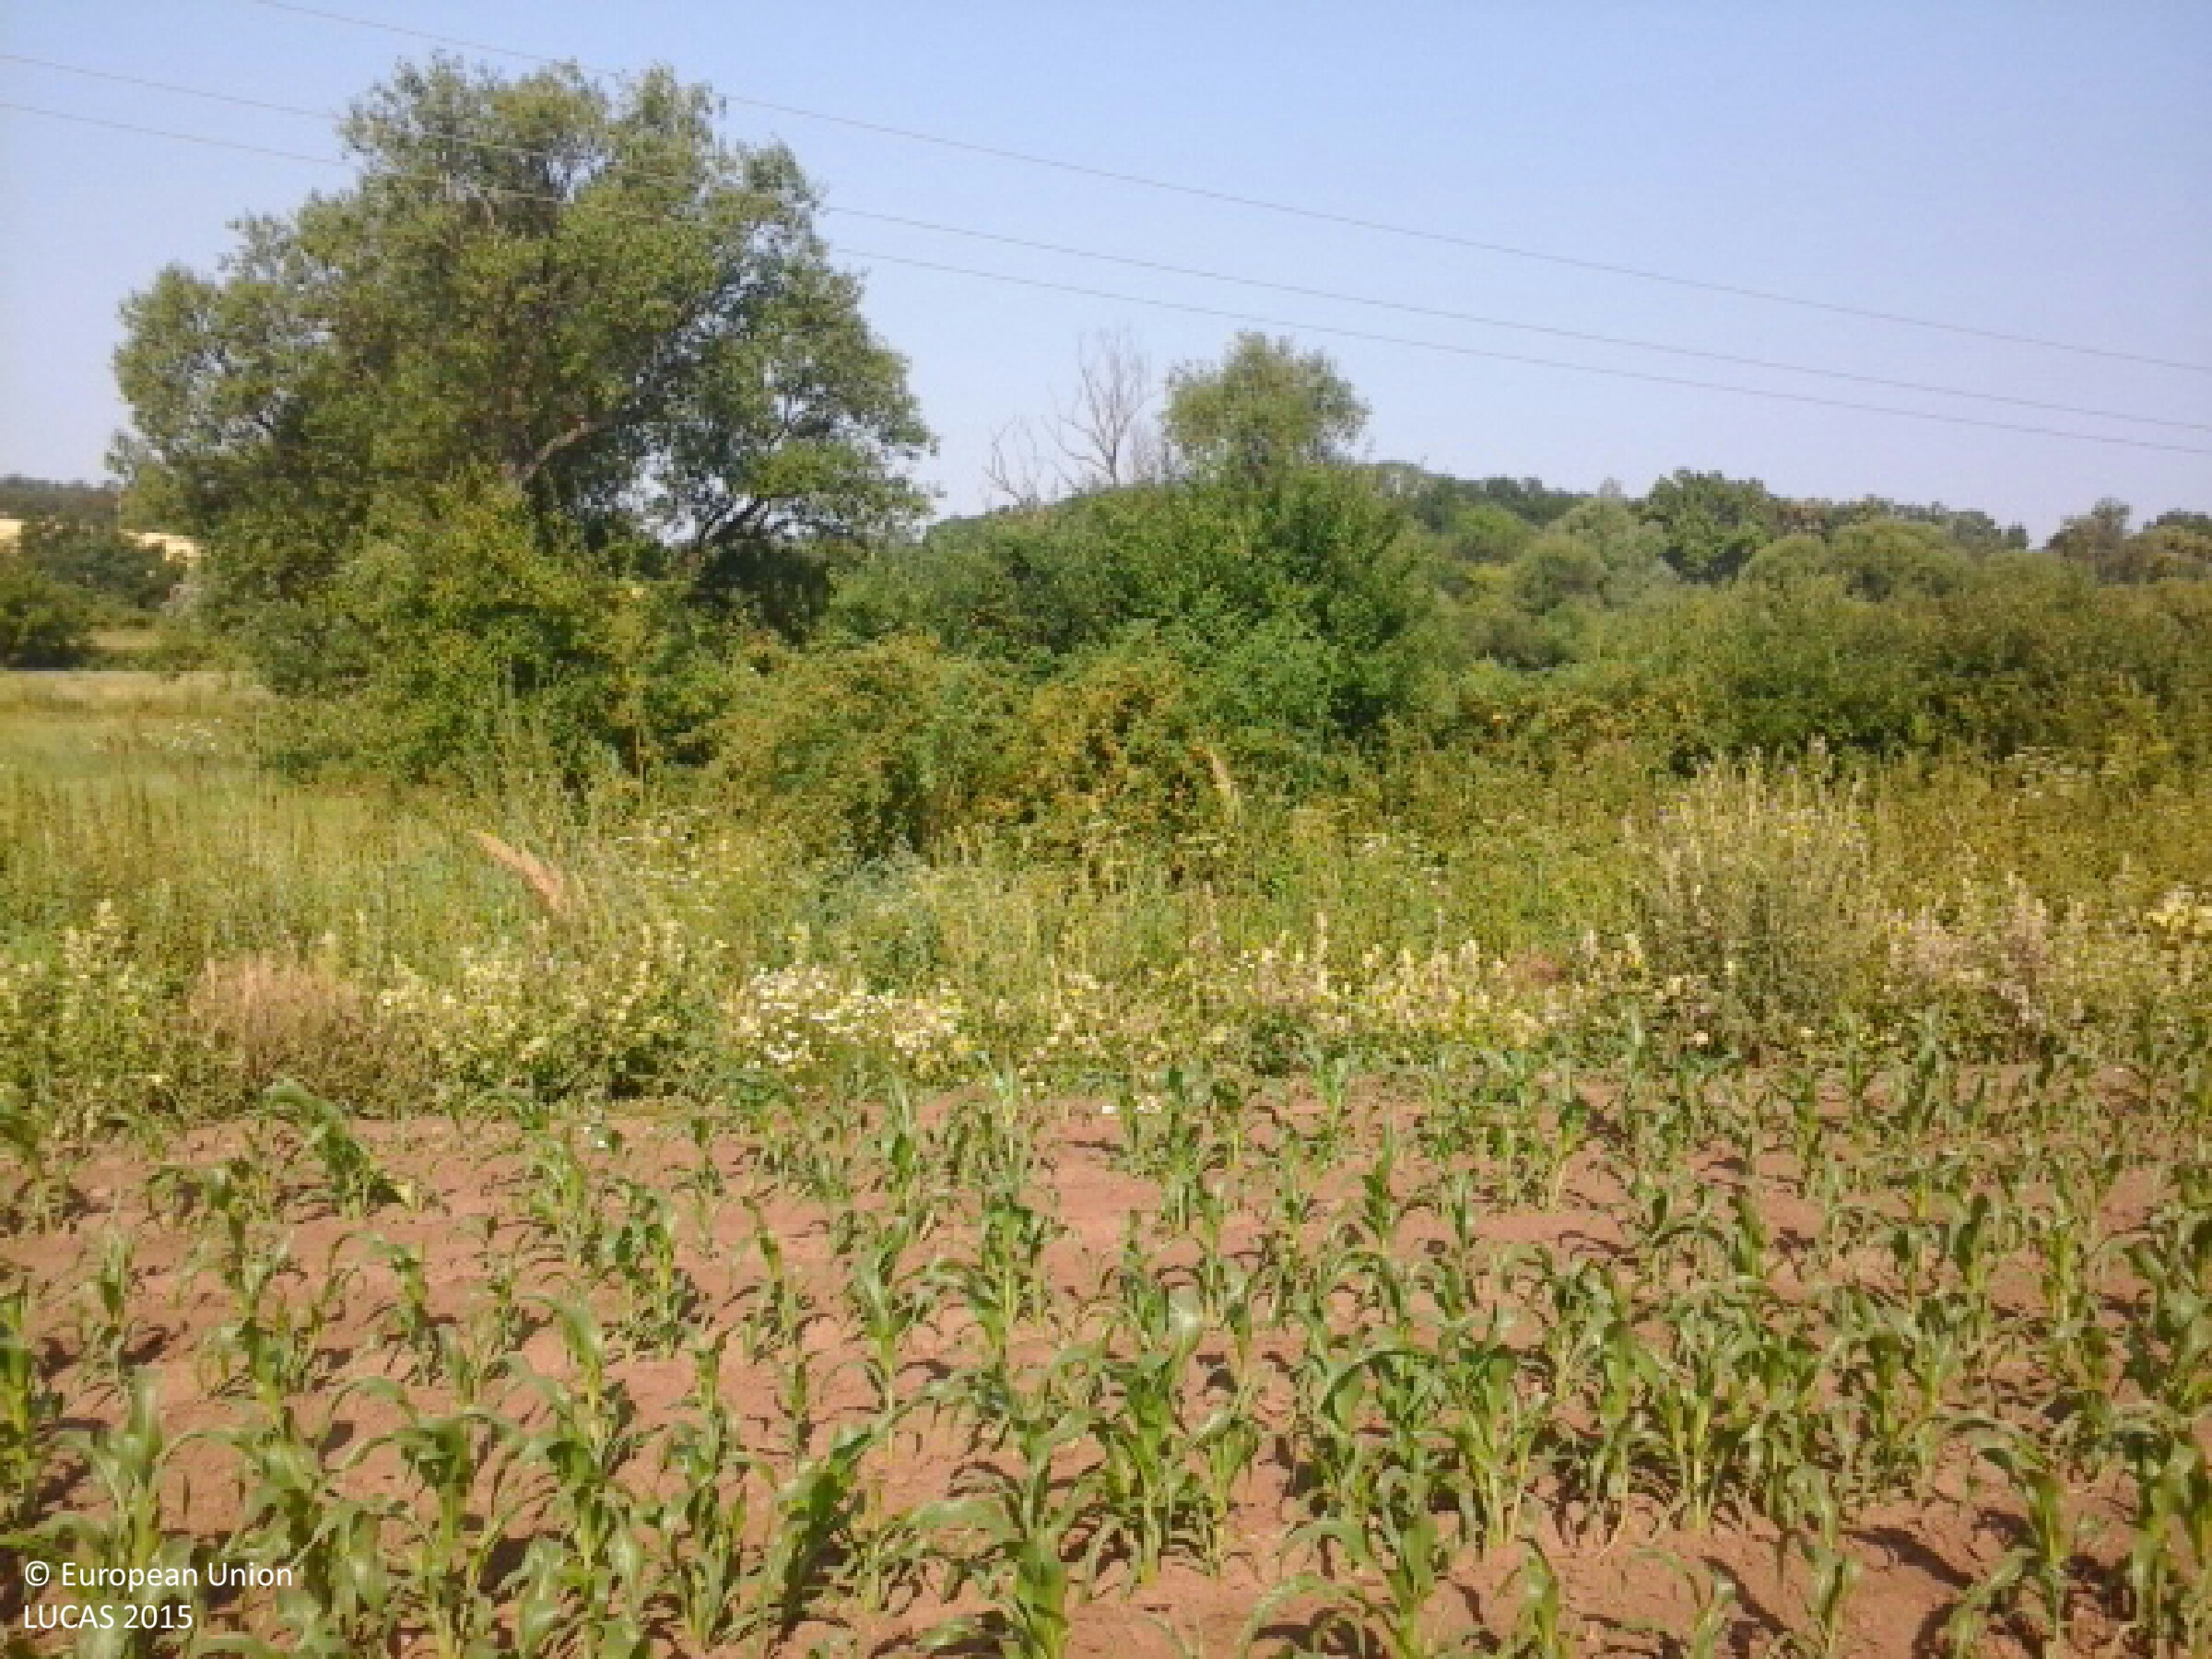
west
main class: Cropland
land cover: Maize
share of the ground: 25 - 50 %
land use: Agriculture (excluding fallow land and kitchen gardens)
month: July
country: HU
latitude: 48.1743
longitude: 21.0540
